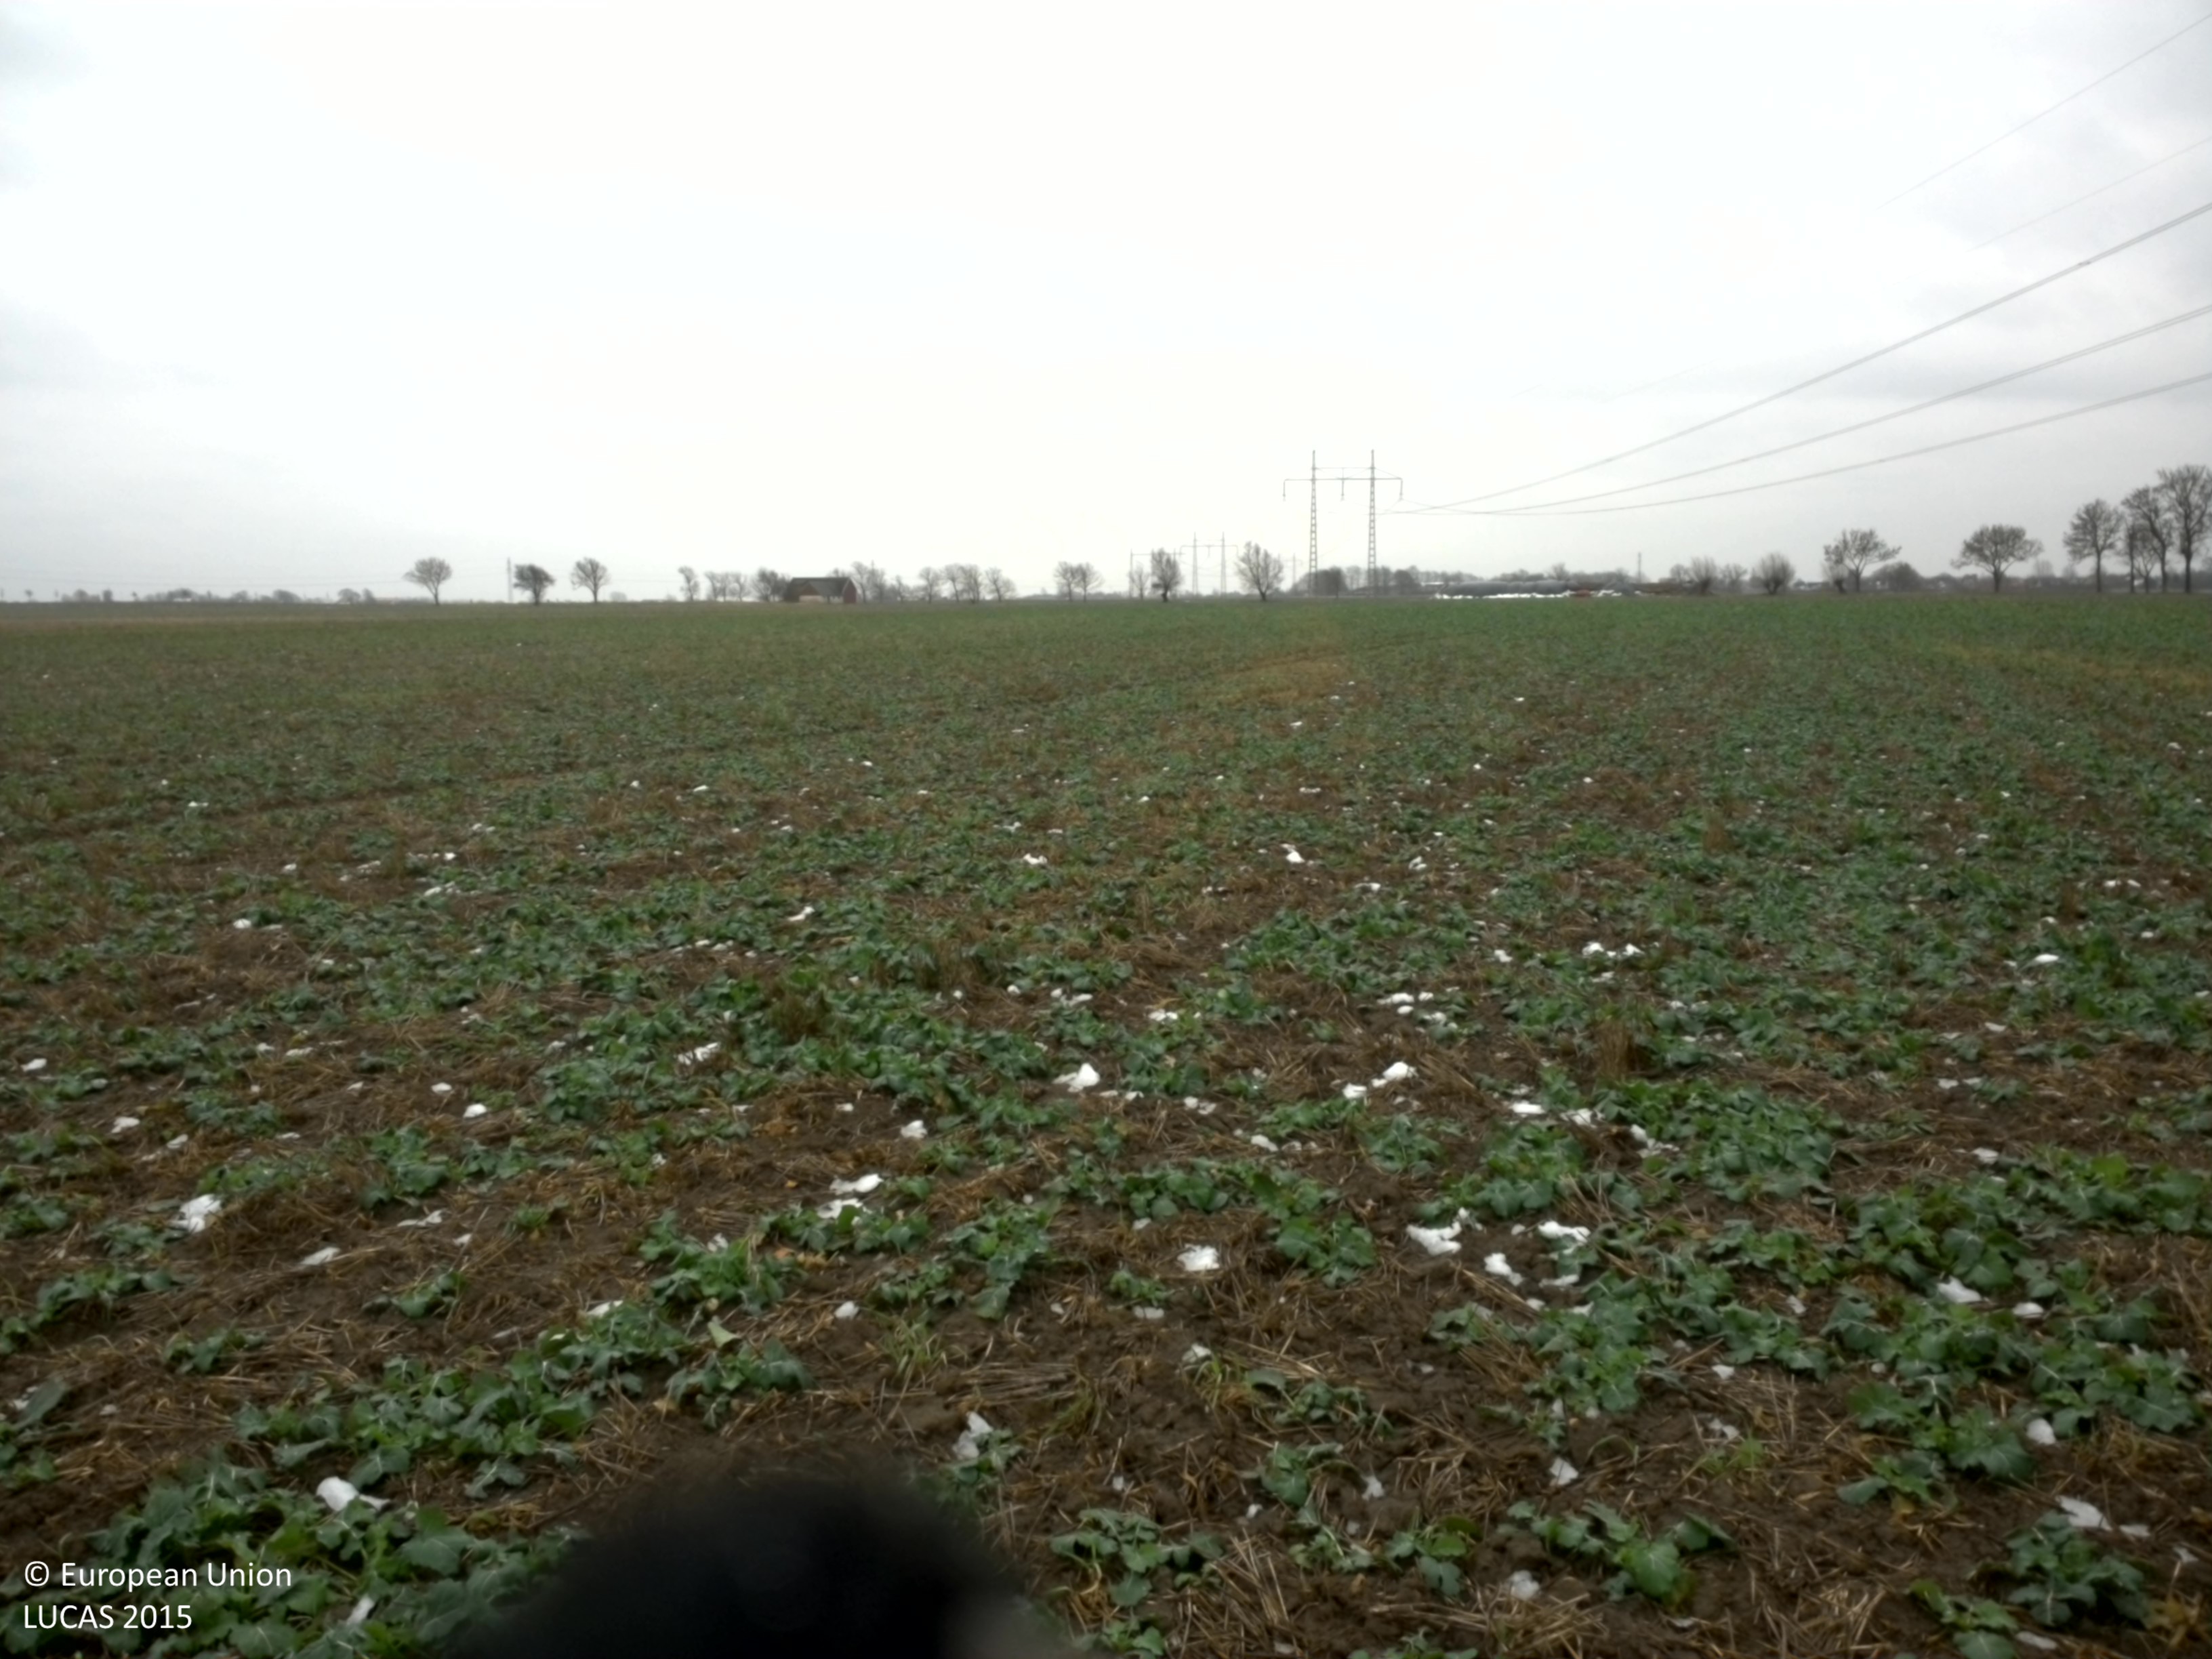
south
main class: Cropland
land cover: Rape and turnip rape
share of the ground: 25 - 50 %
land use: Agriculture (excluding fallow land and kitchen gardens)
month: November
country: SE
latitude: 55.6639
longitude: 13.1296
